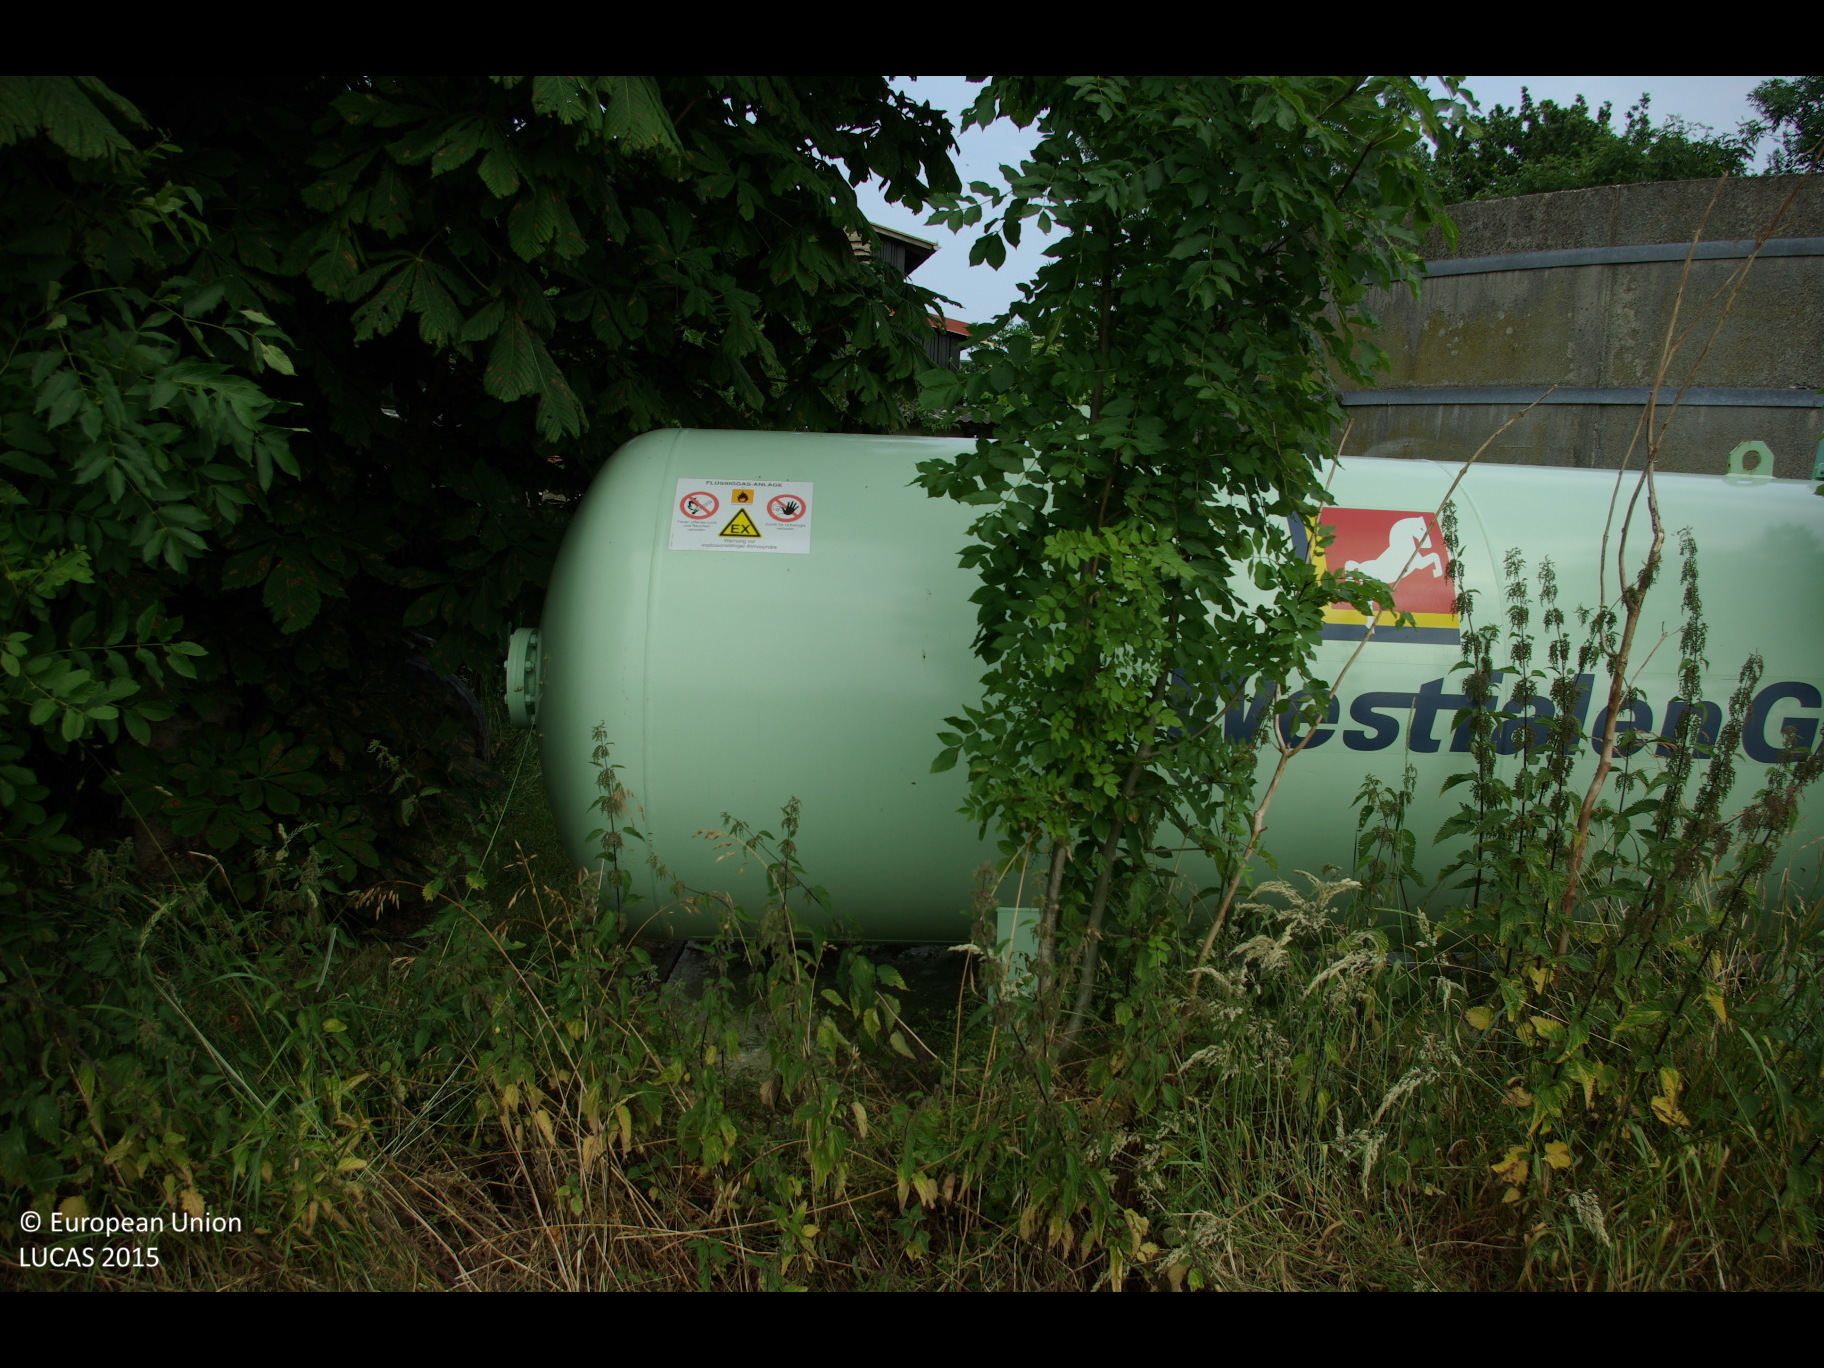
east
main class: Cropland
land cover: Common wheat
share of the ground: > 75 %
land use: Agriculture (excluding fallow land and kitchen gardens)
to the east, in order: Common wheat; Artificial constructions in urban areas; Broadleaved woodland; Grassland without tree/shrub cover; Common wheat
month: July
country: DE
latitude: 54.7139
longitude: 9.9224
